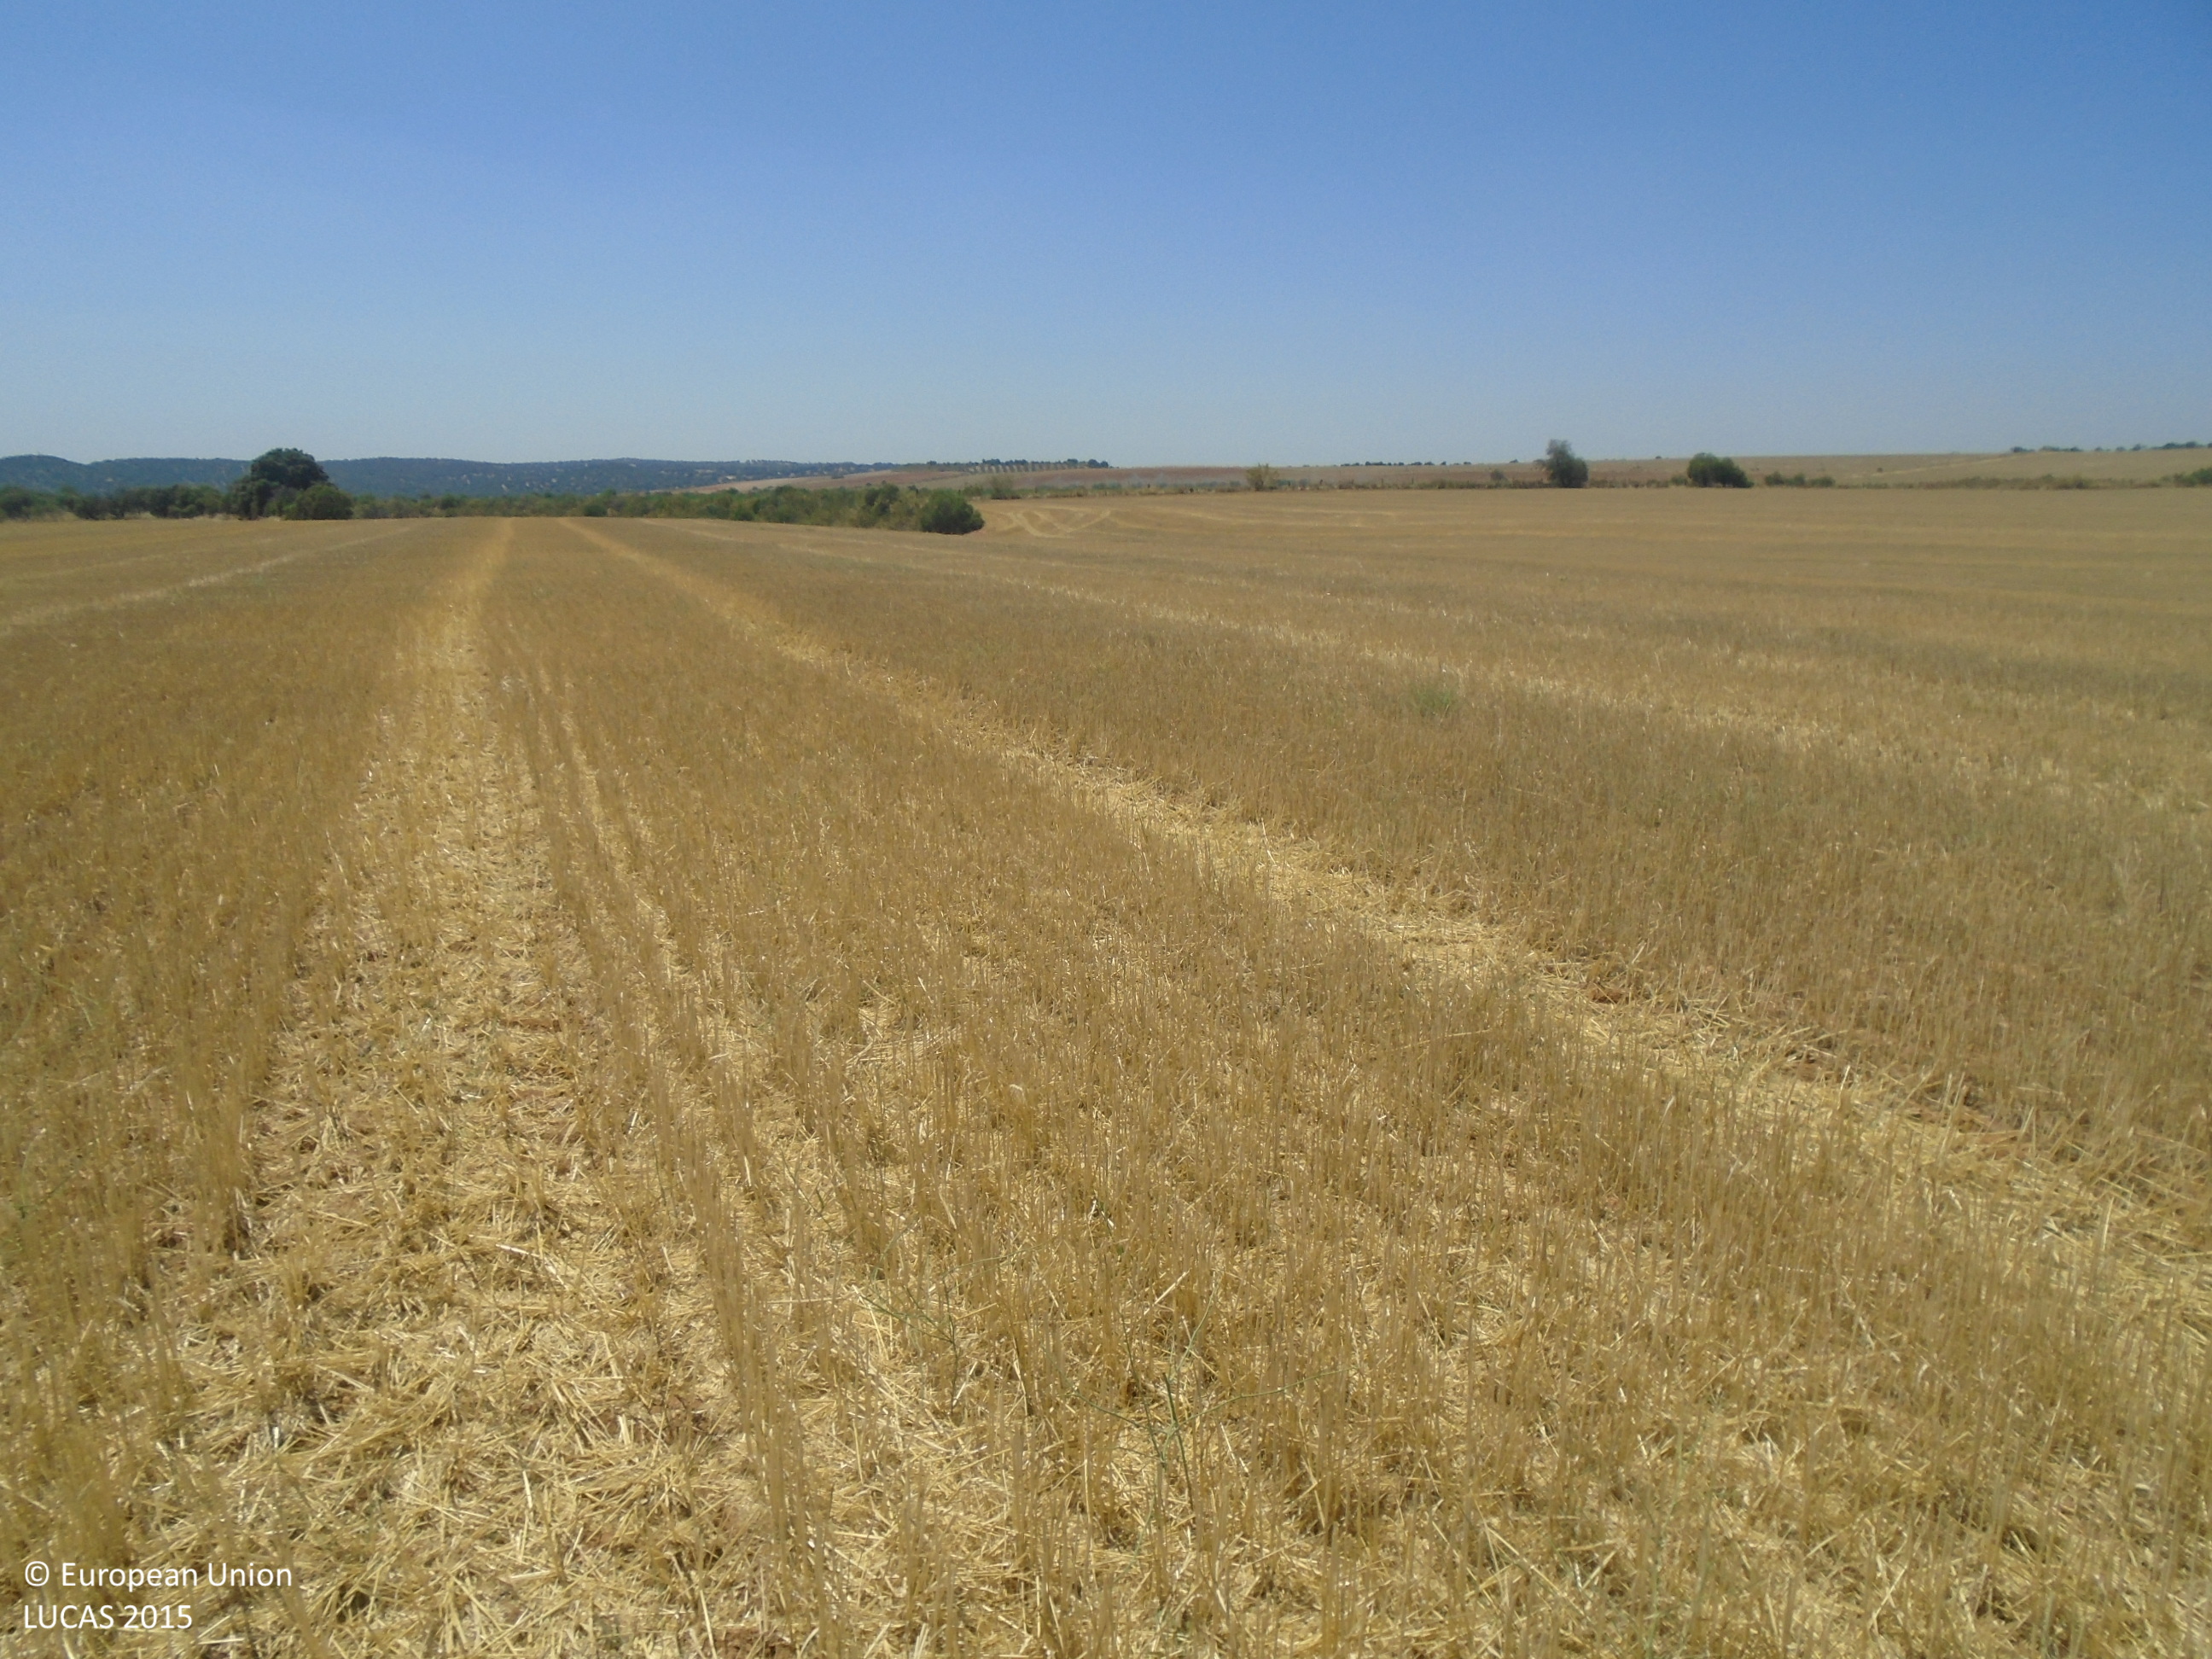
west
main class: Cropland
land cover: Common wheat
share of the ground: > 75 %
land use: Agriculture (excluding fallow land and kitchen gardens)
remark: Harvested field
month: July
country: ES
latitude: 39.8103
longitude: -4.9644
